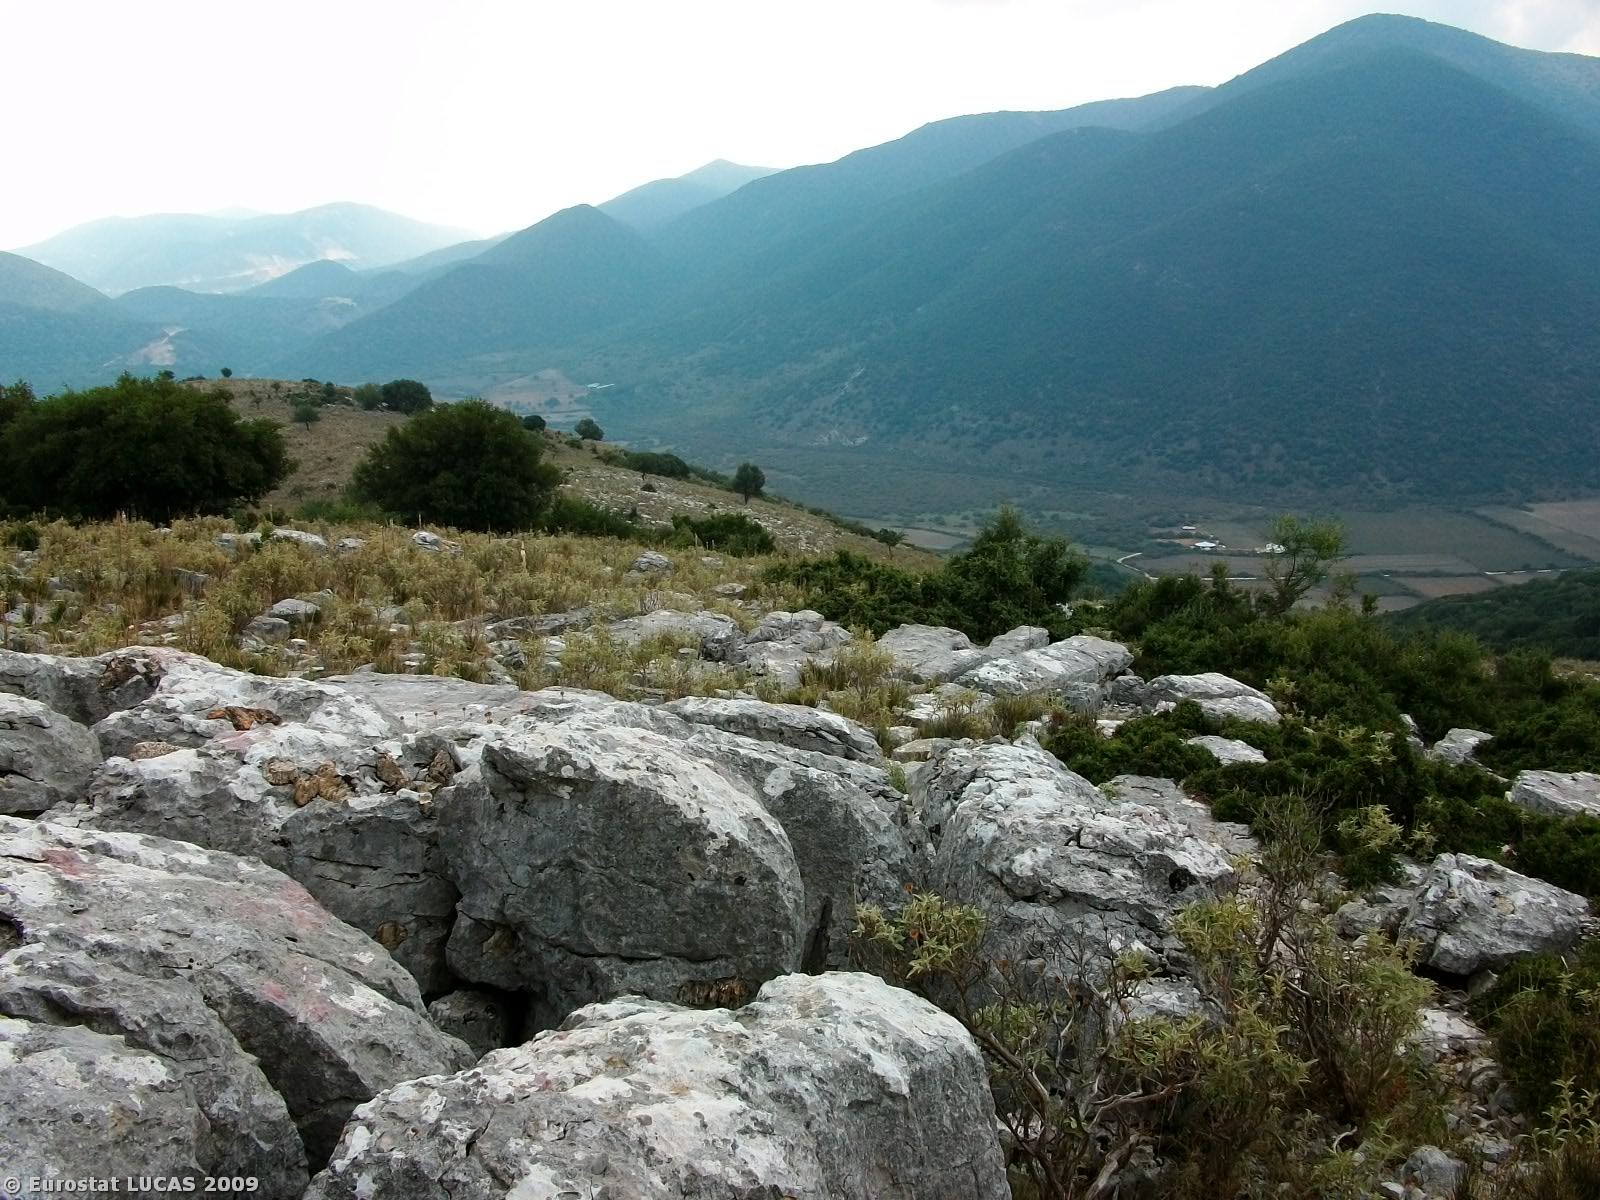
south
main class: Grassland
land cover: Grassland with sparse tree/shrub cover
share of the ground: > 75 %
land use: Unused
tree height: < 5 m
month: October
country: GR
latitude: 39.4146
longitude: 20.4620
